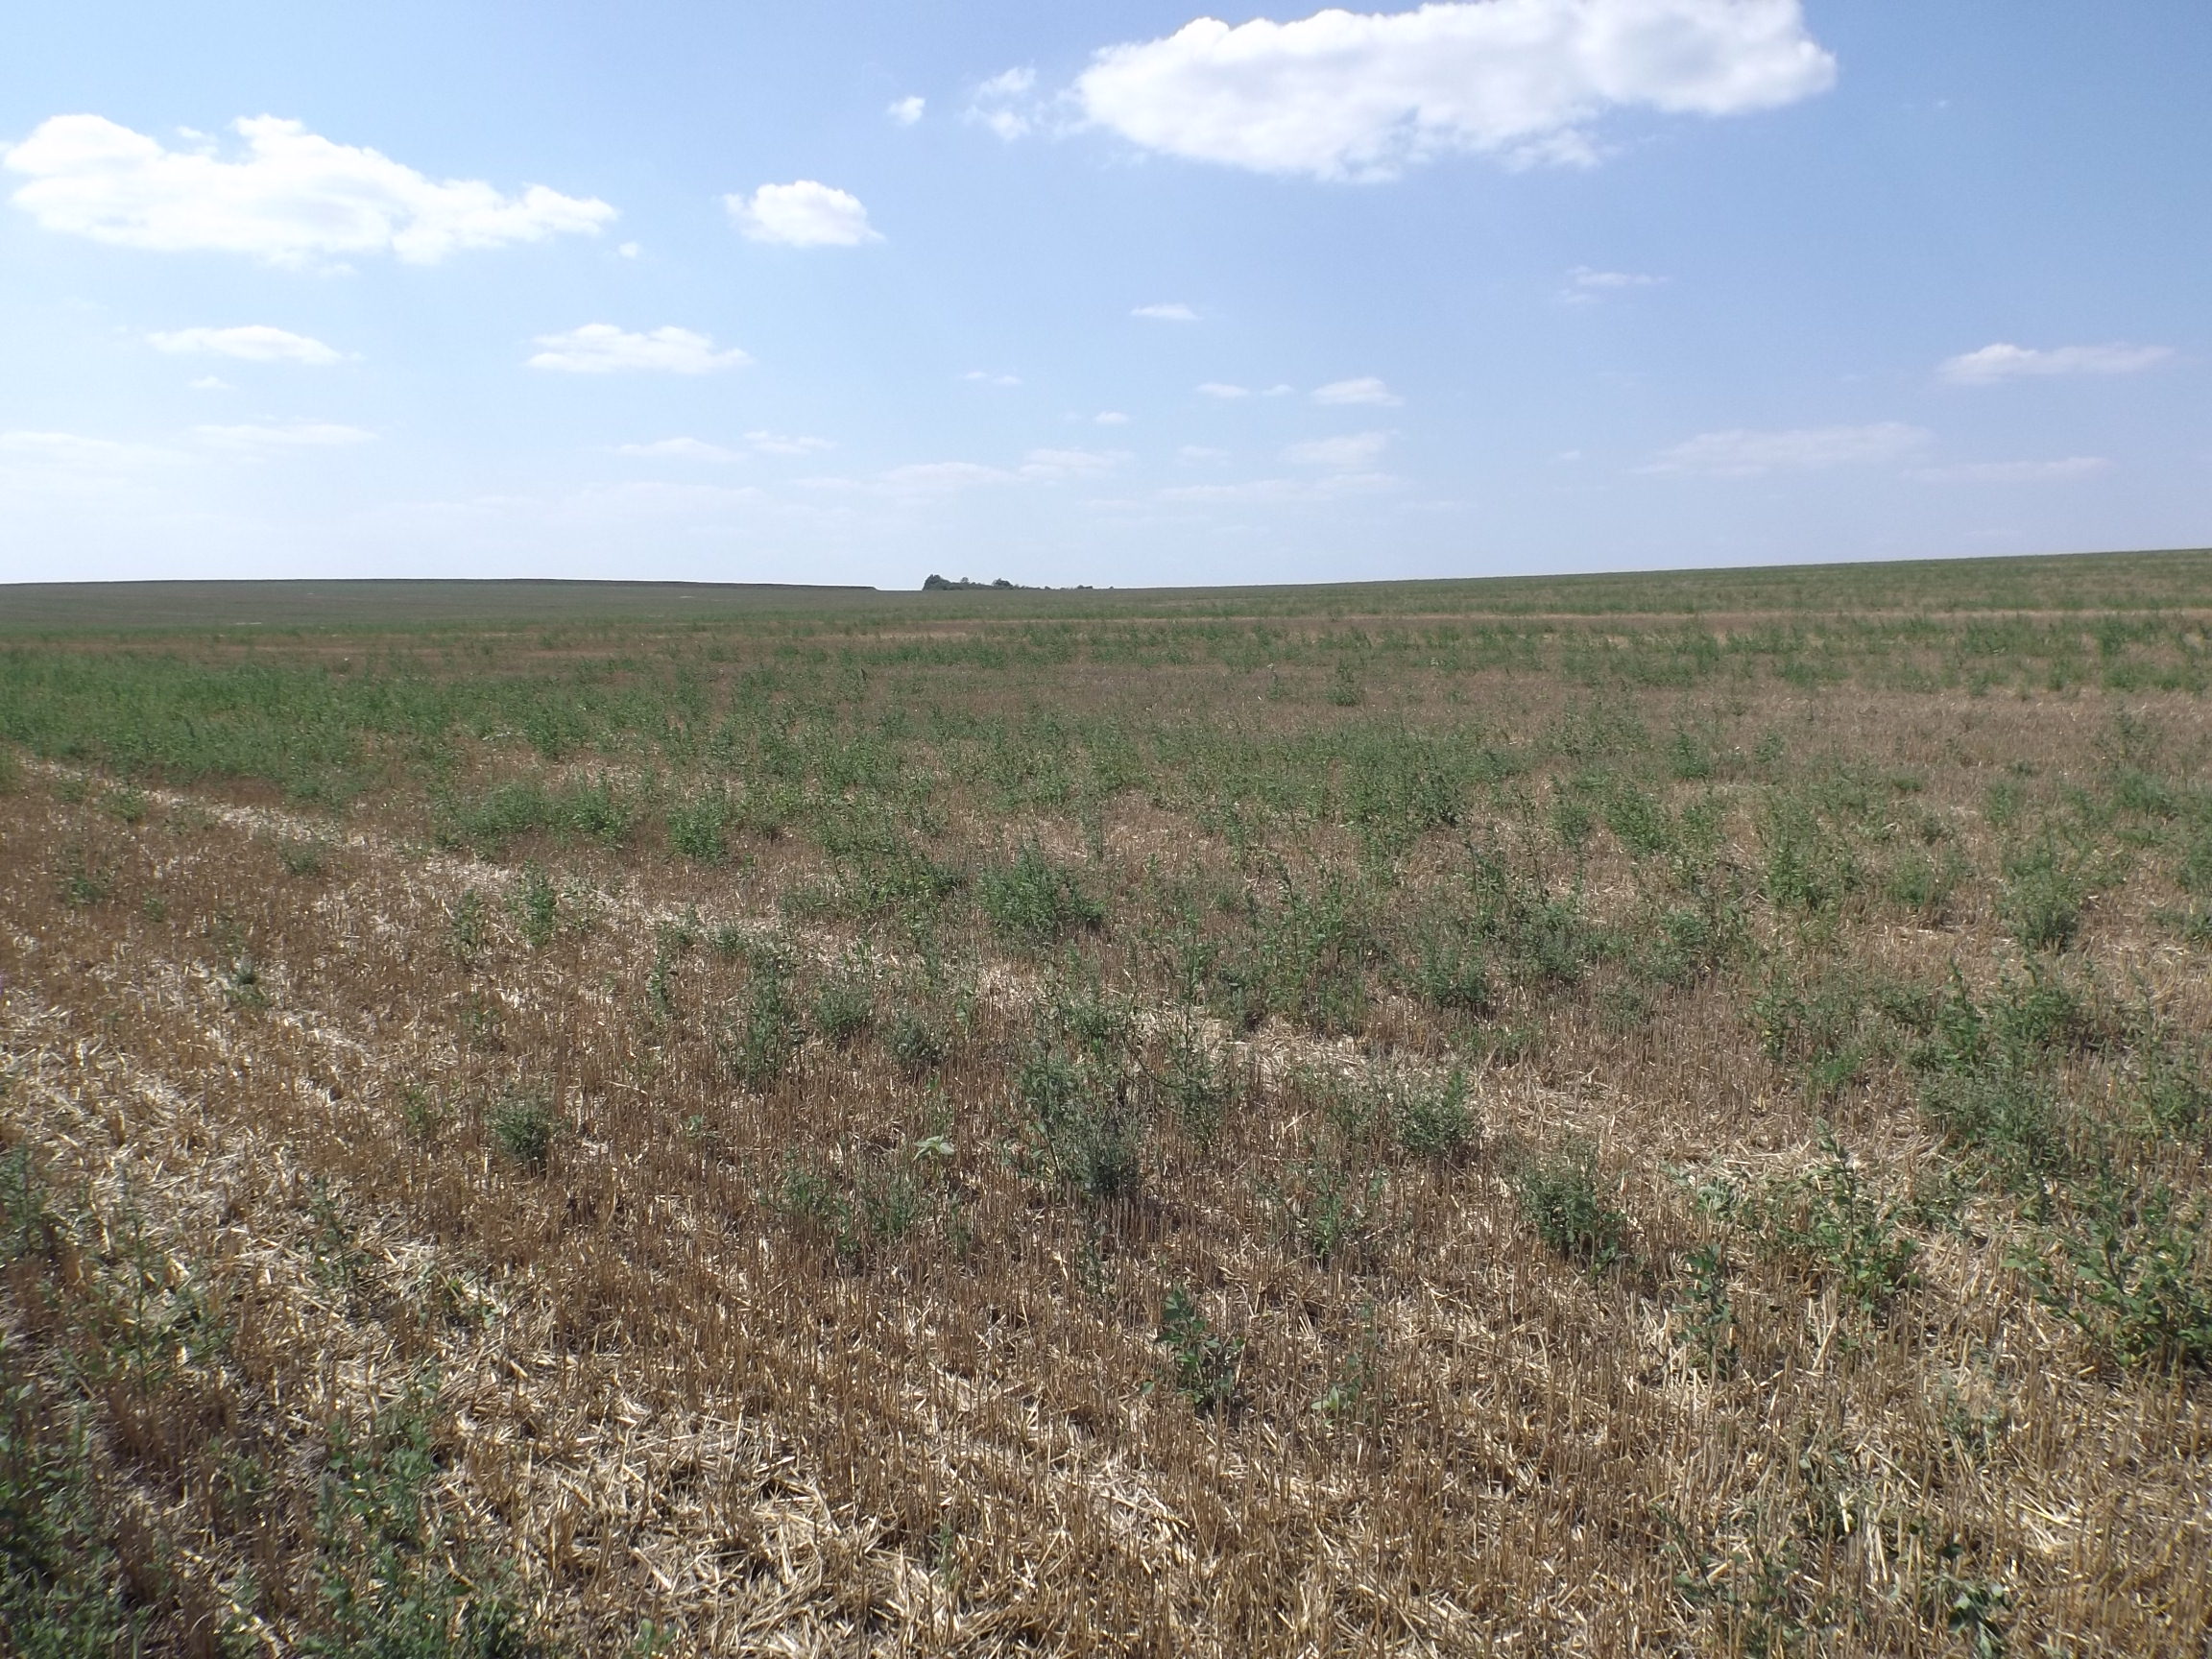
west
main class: Cropland
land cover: Common wheat
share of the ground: 50 - 75 %
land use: Agriculture (excluding fallow land and kitchen gardens)
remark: Harvested field
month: August
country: BG
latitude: 43.4406
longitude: 27.4893
